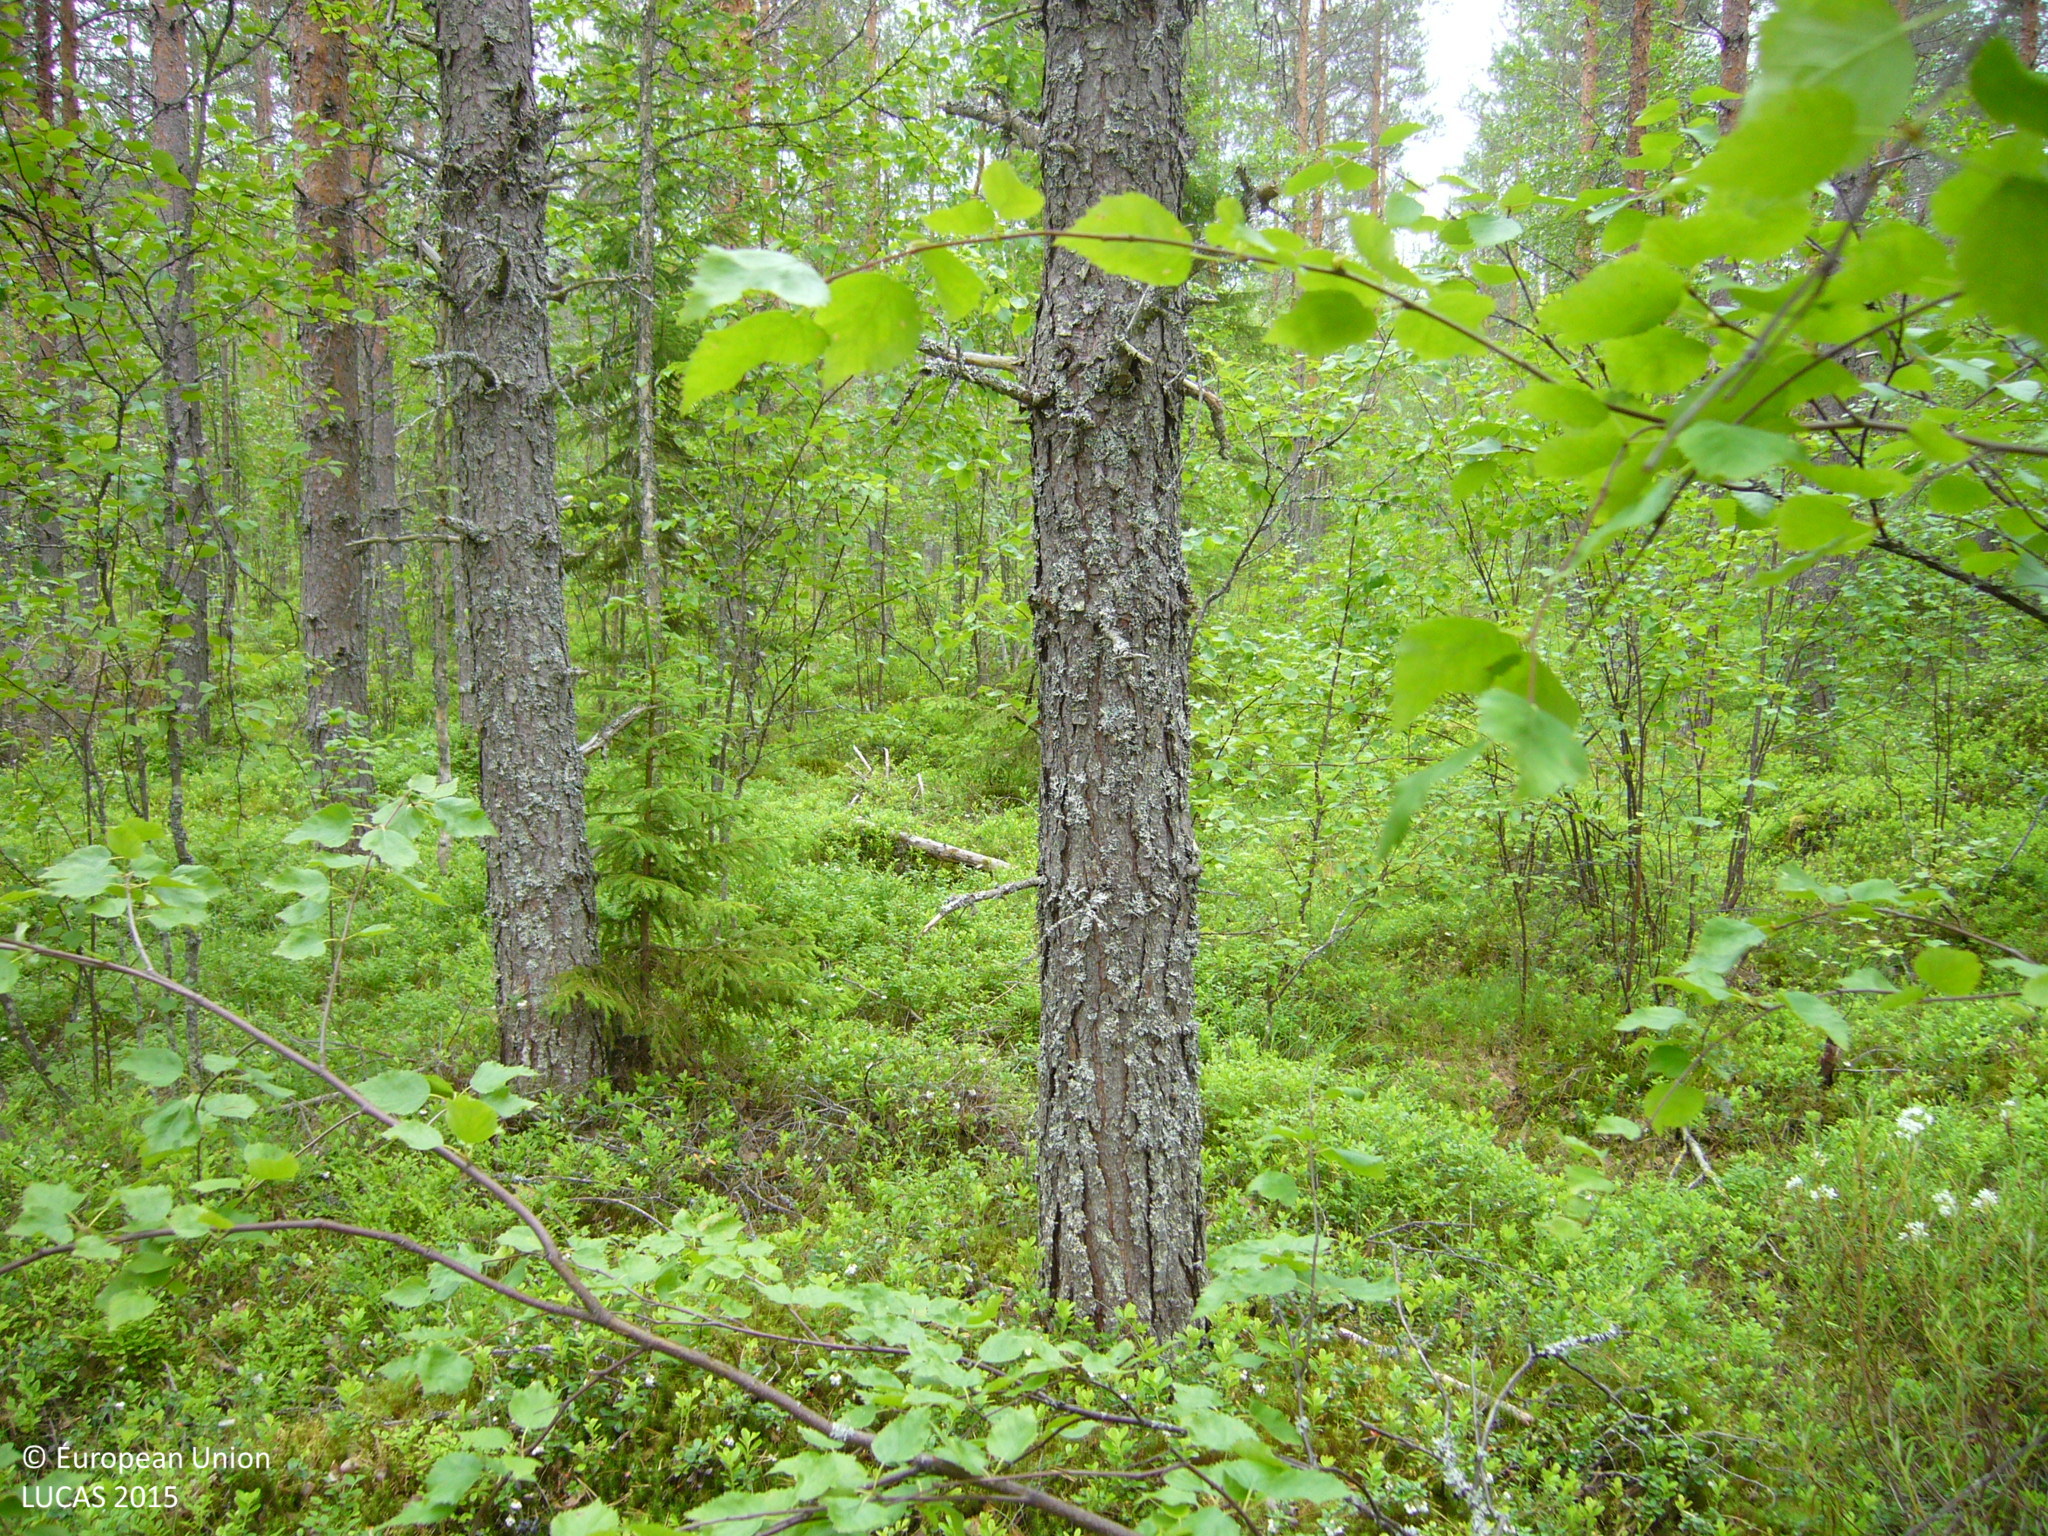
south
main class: Woodland
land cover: Pine dominated mixed woodland
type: boreal forest
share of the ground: 50 - 75 %
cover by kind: coniferous forest trees 50 %, shrubs 30 %, broadleaved forest trees 20 %
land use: Forestry
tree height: > 5 m
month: July
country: FI
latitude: 63.3126
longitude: 26.0631
